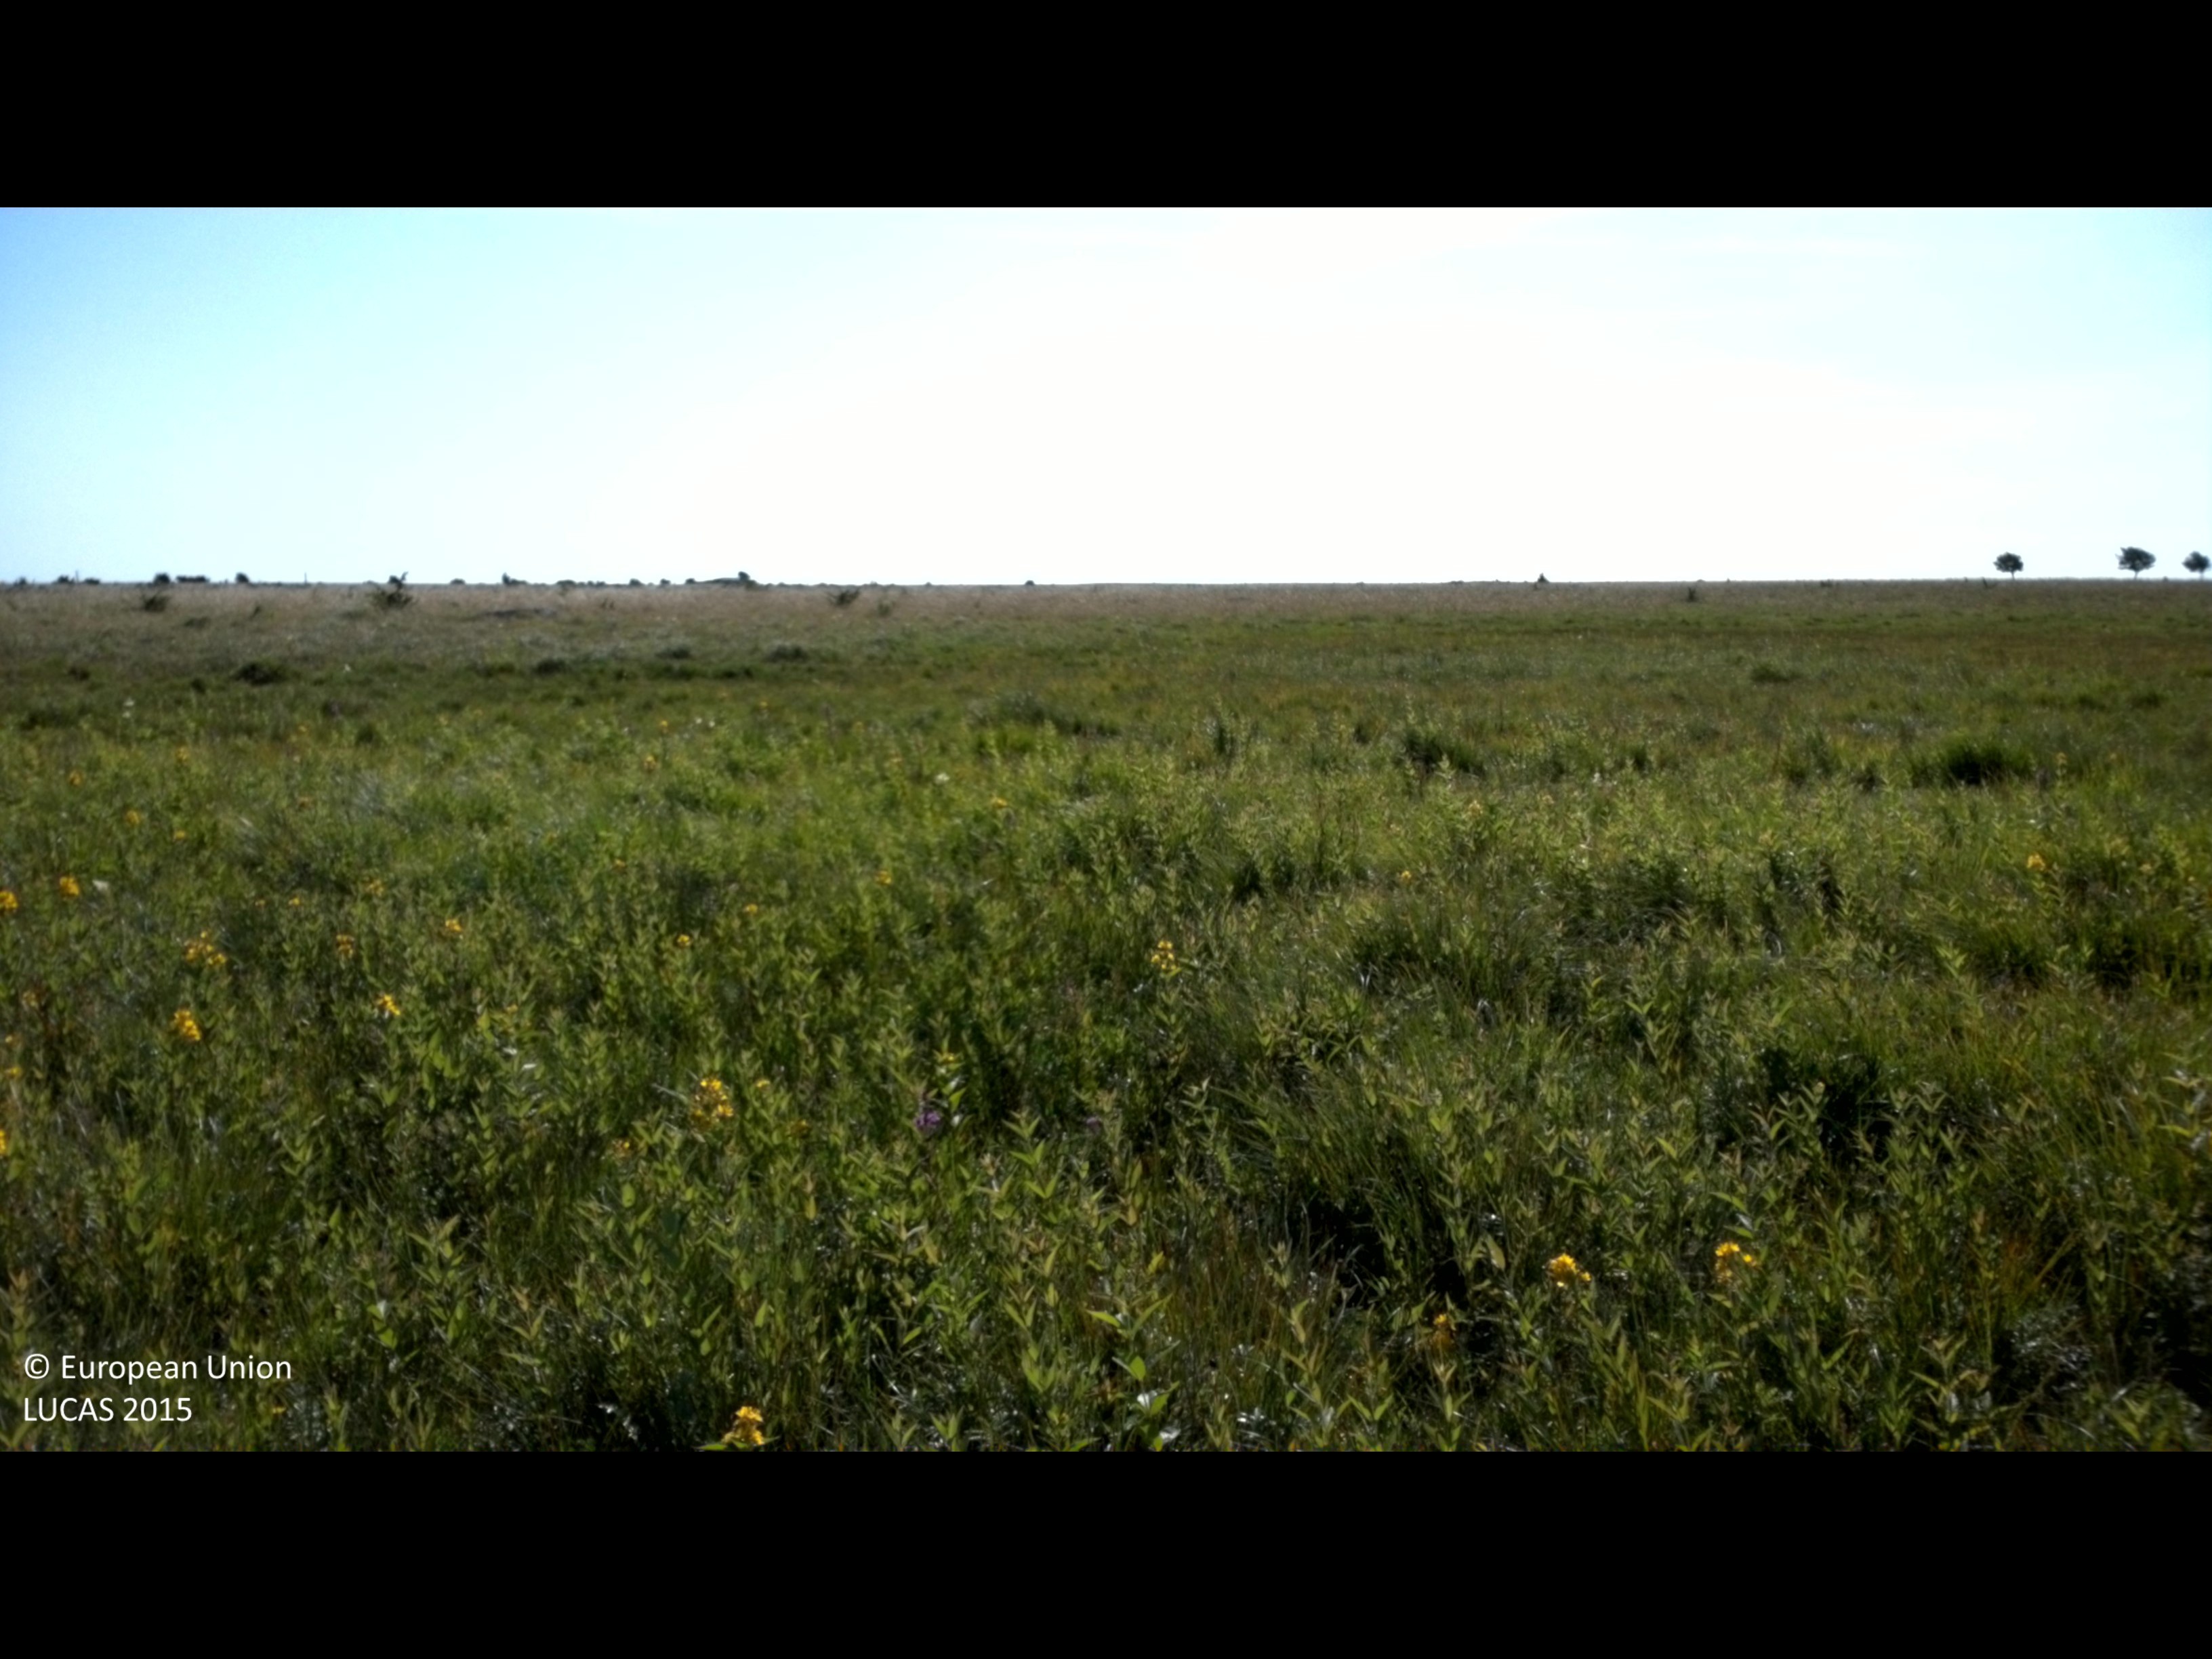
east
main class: Grassland
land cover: Grassland without tree/shrub cover
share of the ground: > 75 %
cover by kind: herbaceous plants 100 %
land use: Agriculture (excluding fallow land and kitchen gardens)
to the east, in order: Grassland without tree/shrub cover; Dry stone walls; Fences; Grassland without tree/shrub cover
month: July
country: SE
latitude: 56.9235
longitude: 16.8859
